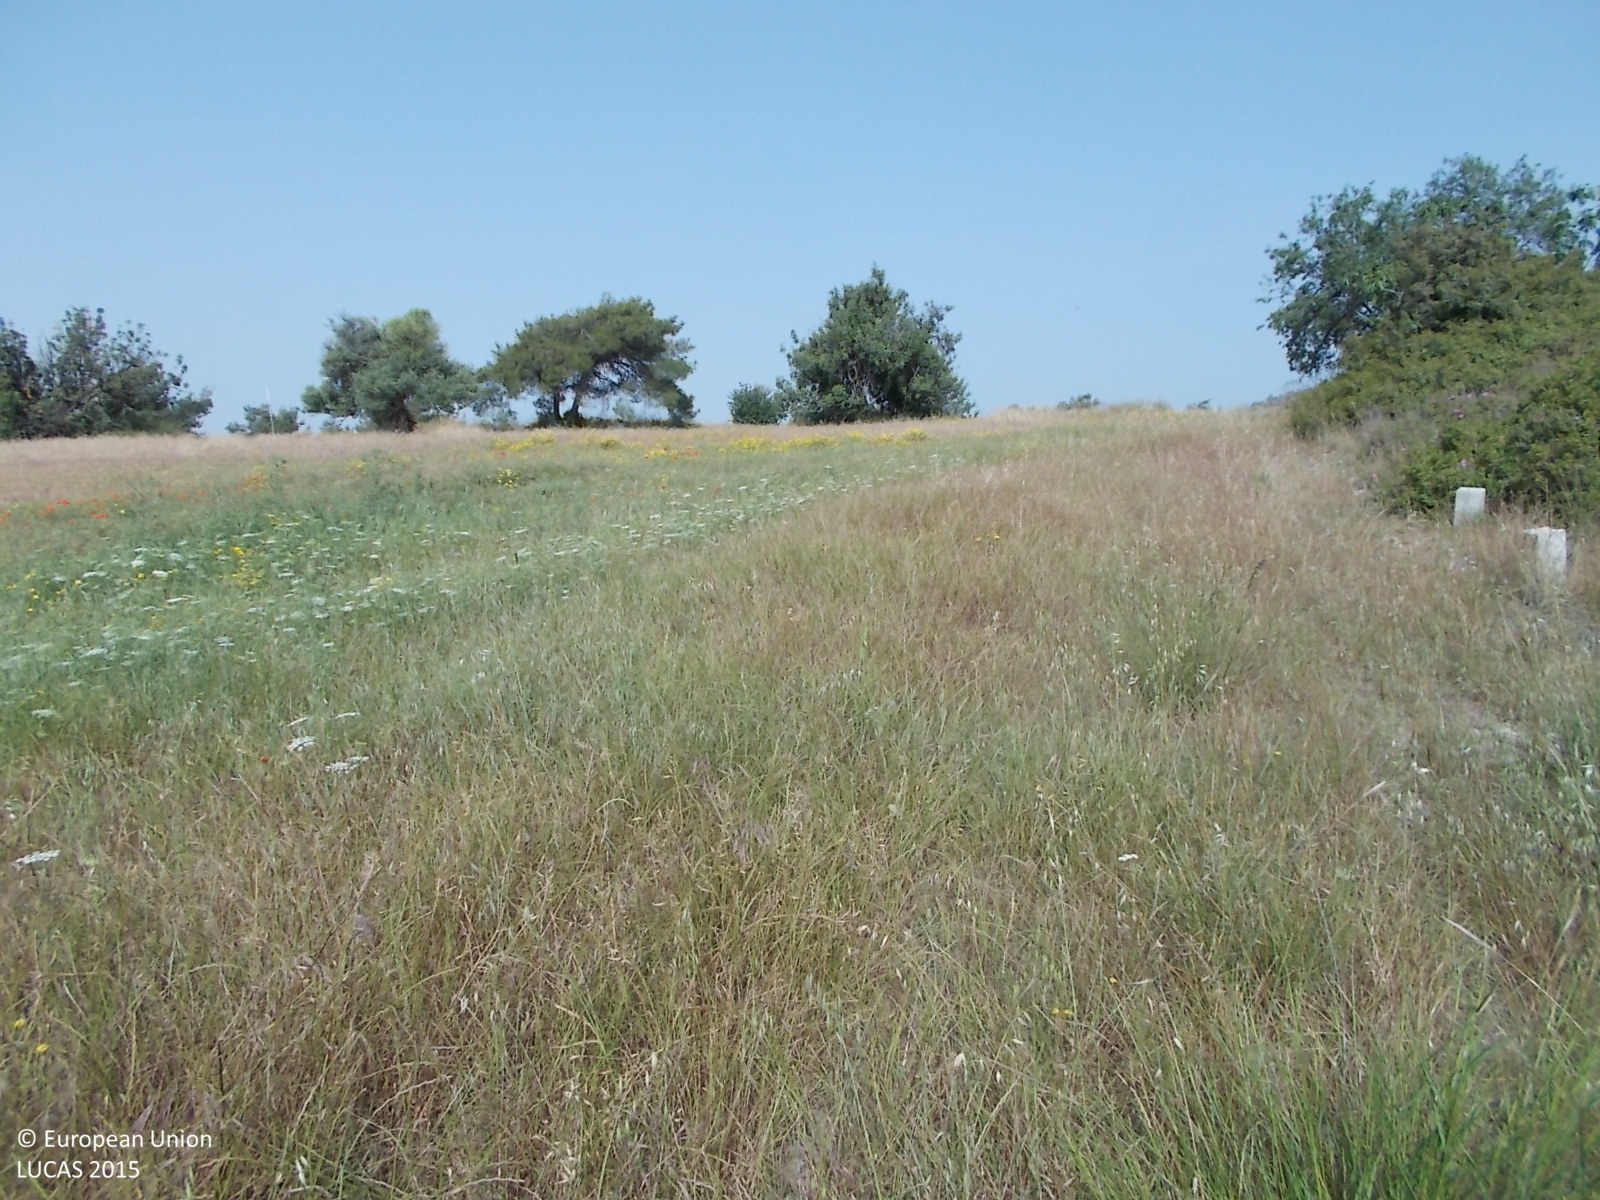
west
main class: Grassland
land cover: Spontaneously vegetated surfaces
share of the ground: > 75 %
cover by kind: herbaceous plants 100 %
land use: Fallow land
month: April
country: CY
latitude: 34.7566
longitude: 33.1456
